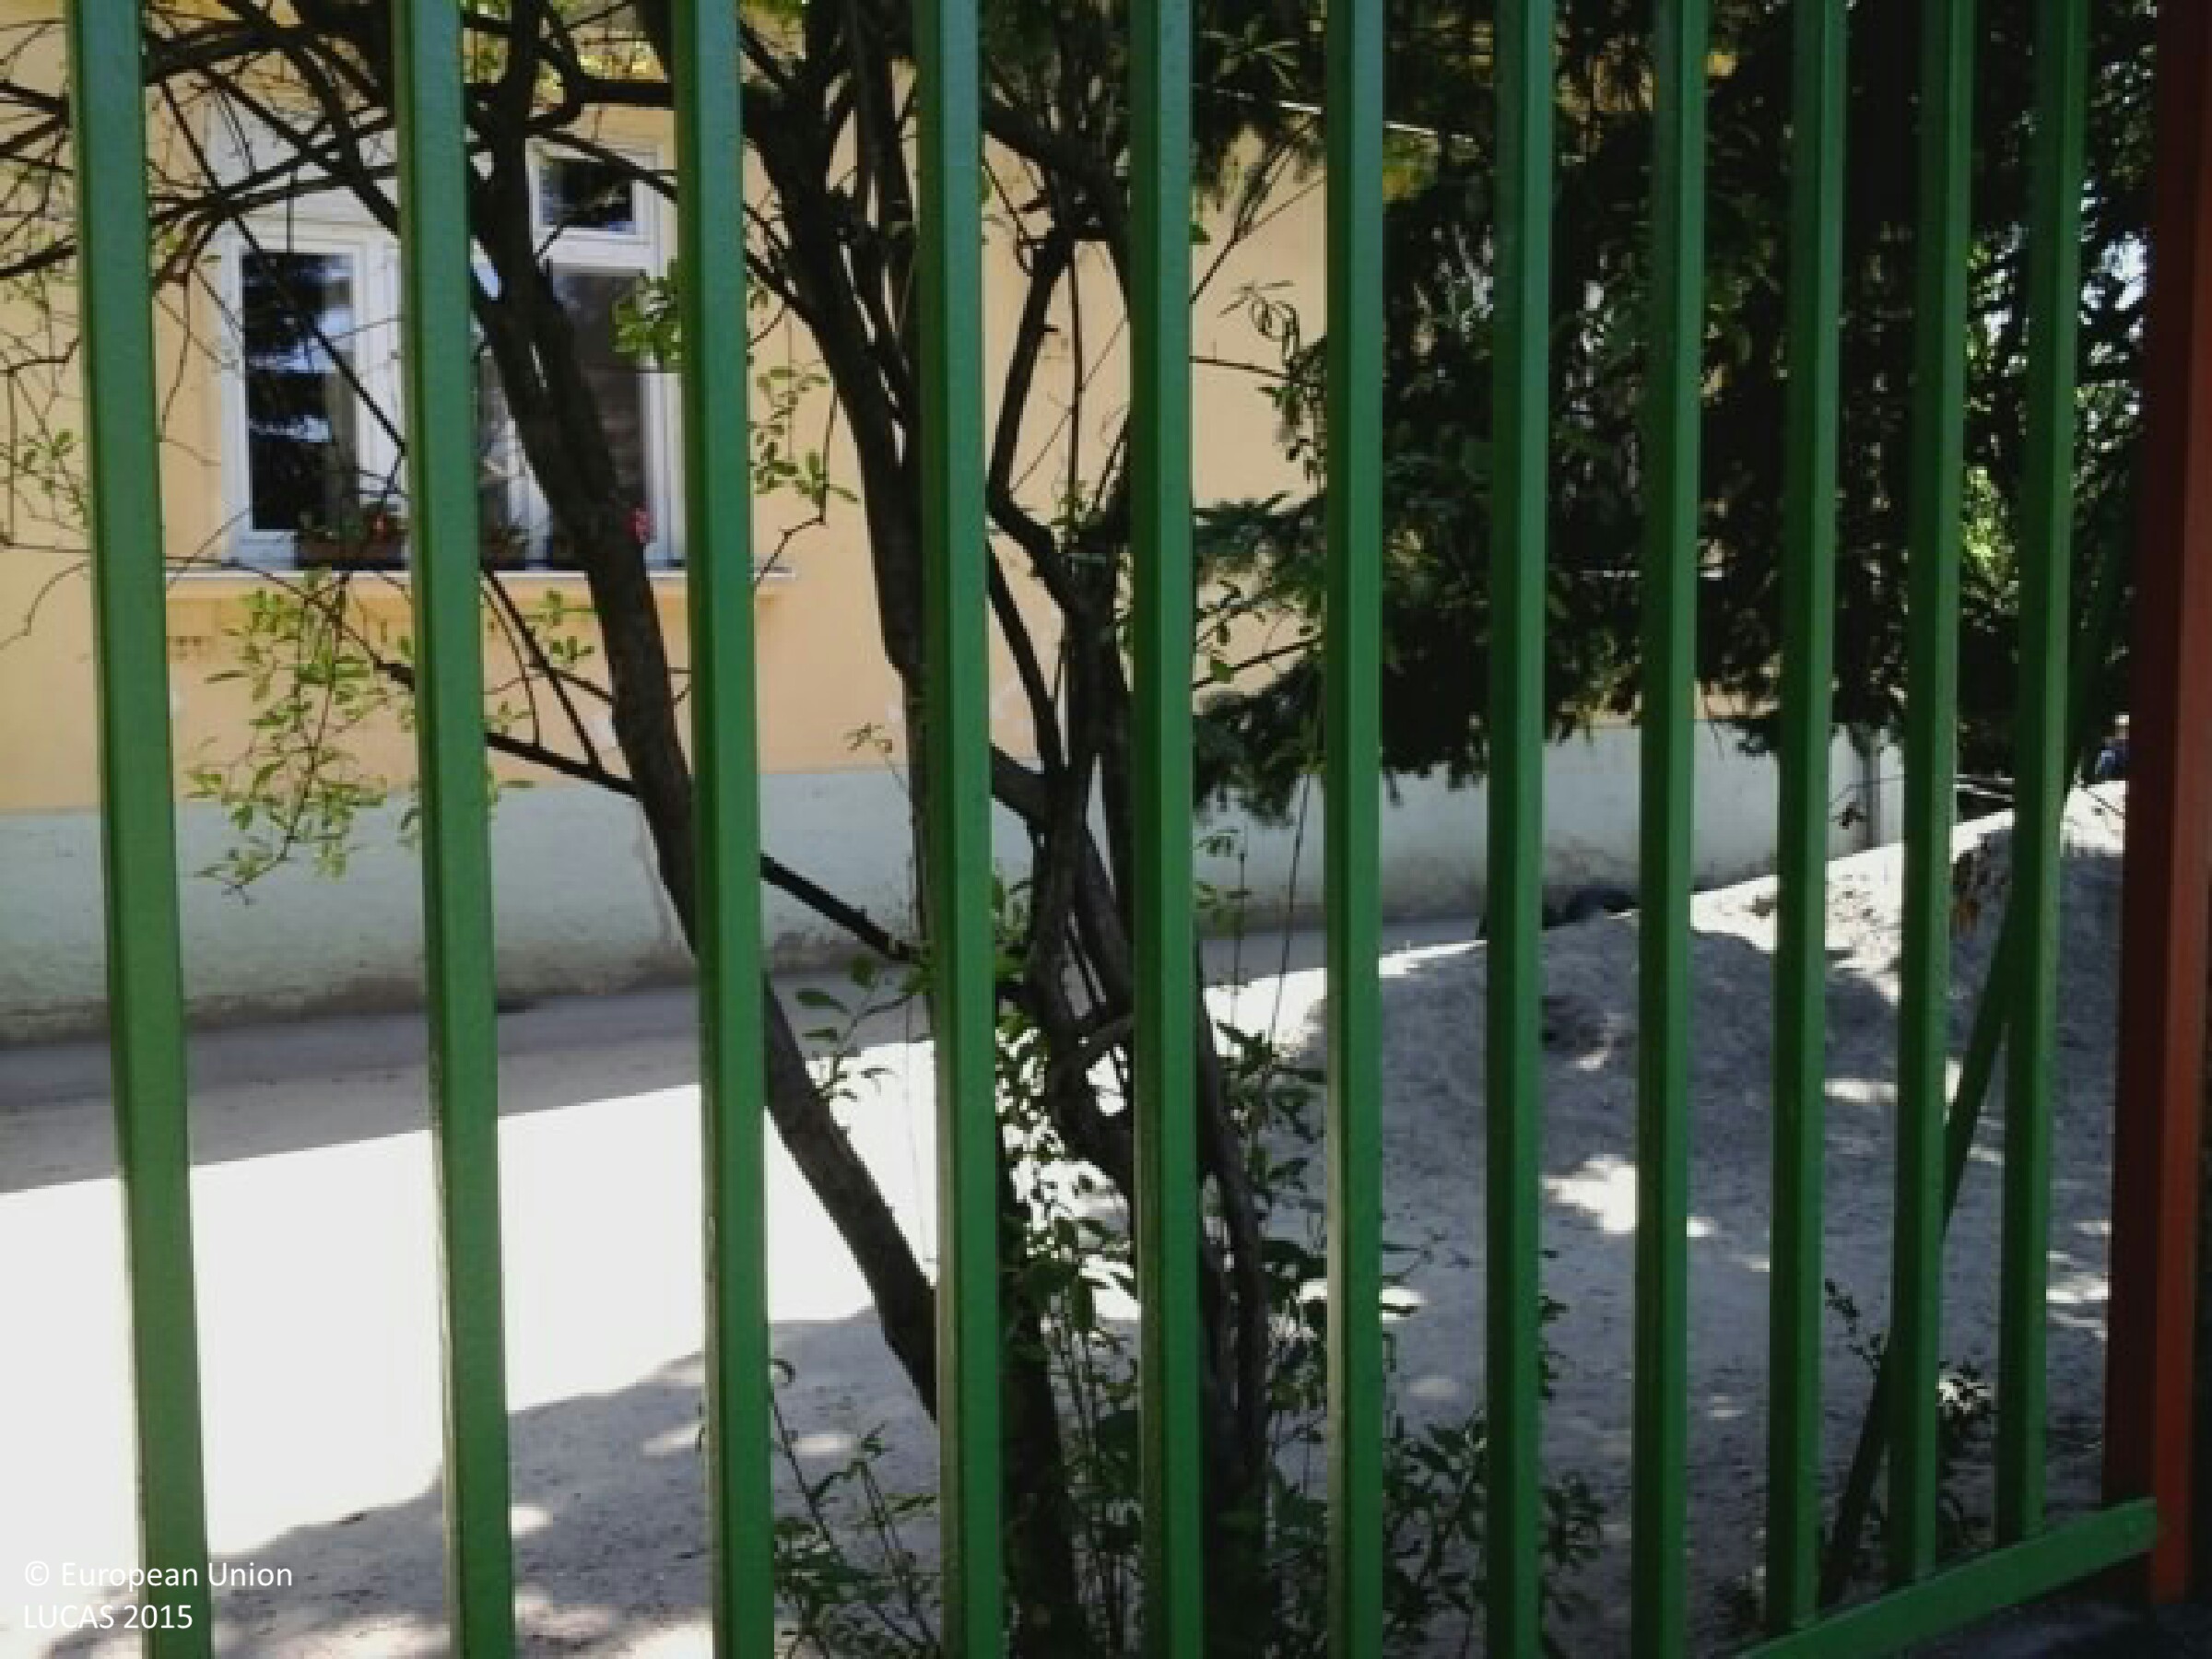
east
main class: Woodland
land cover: Broadleaved woodland
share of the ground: > 75 %
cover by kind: broadleaved forest trees 95 %, coniferous forest trees 5 %
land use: Community services
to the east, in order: Broadleaved woodland; Artificial constructions in urban areas
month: June
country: HU
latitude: 47.4881
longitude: 19.2702
